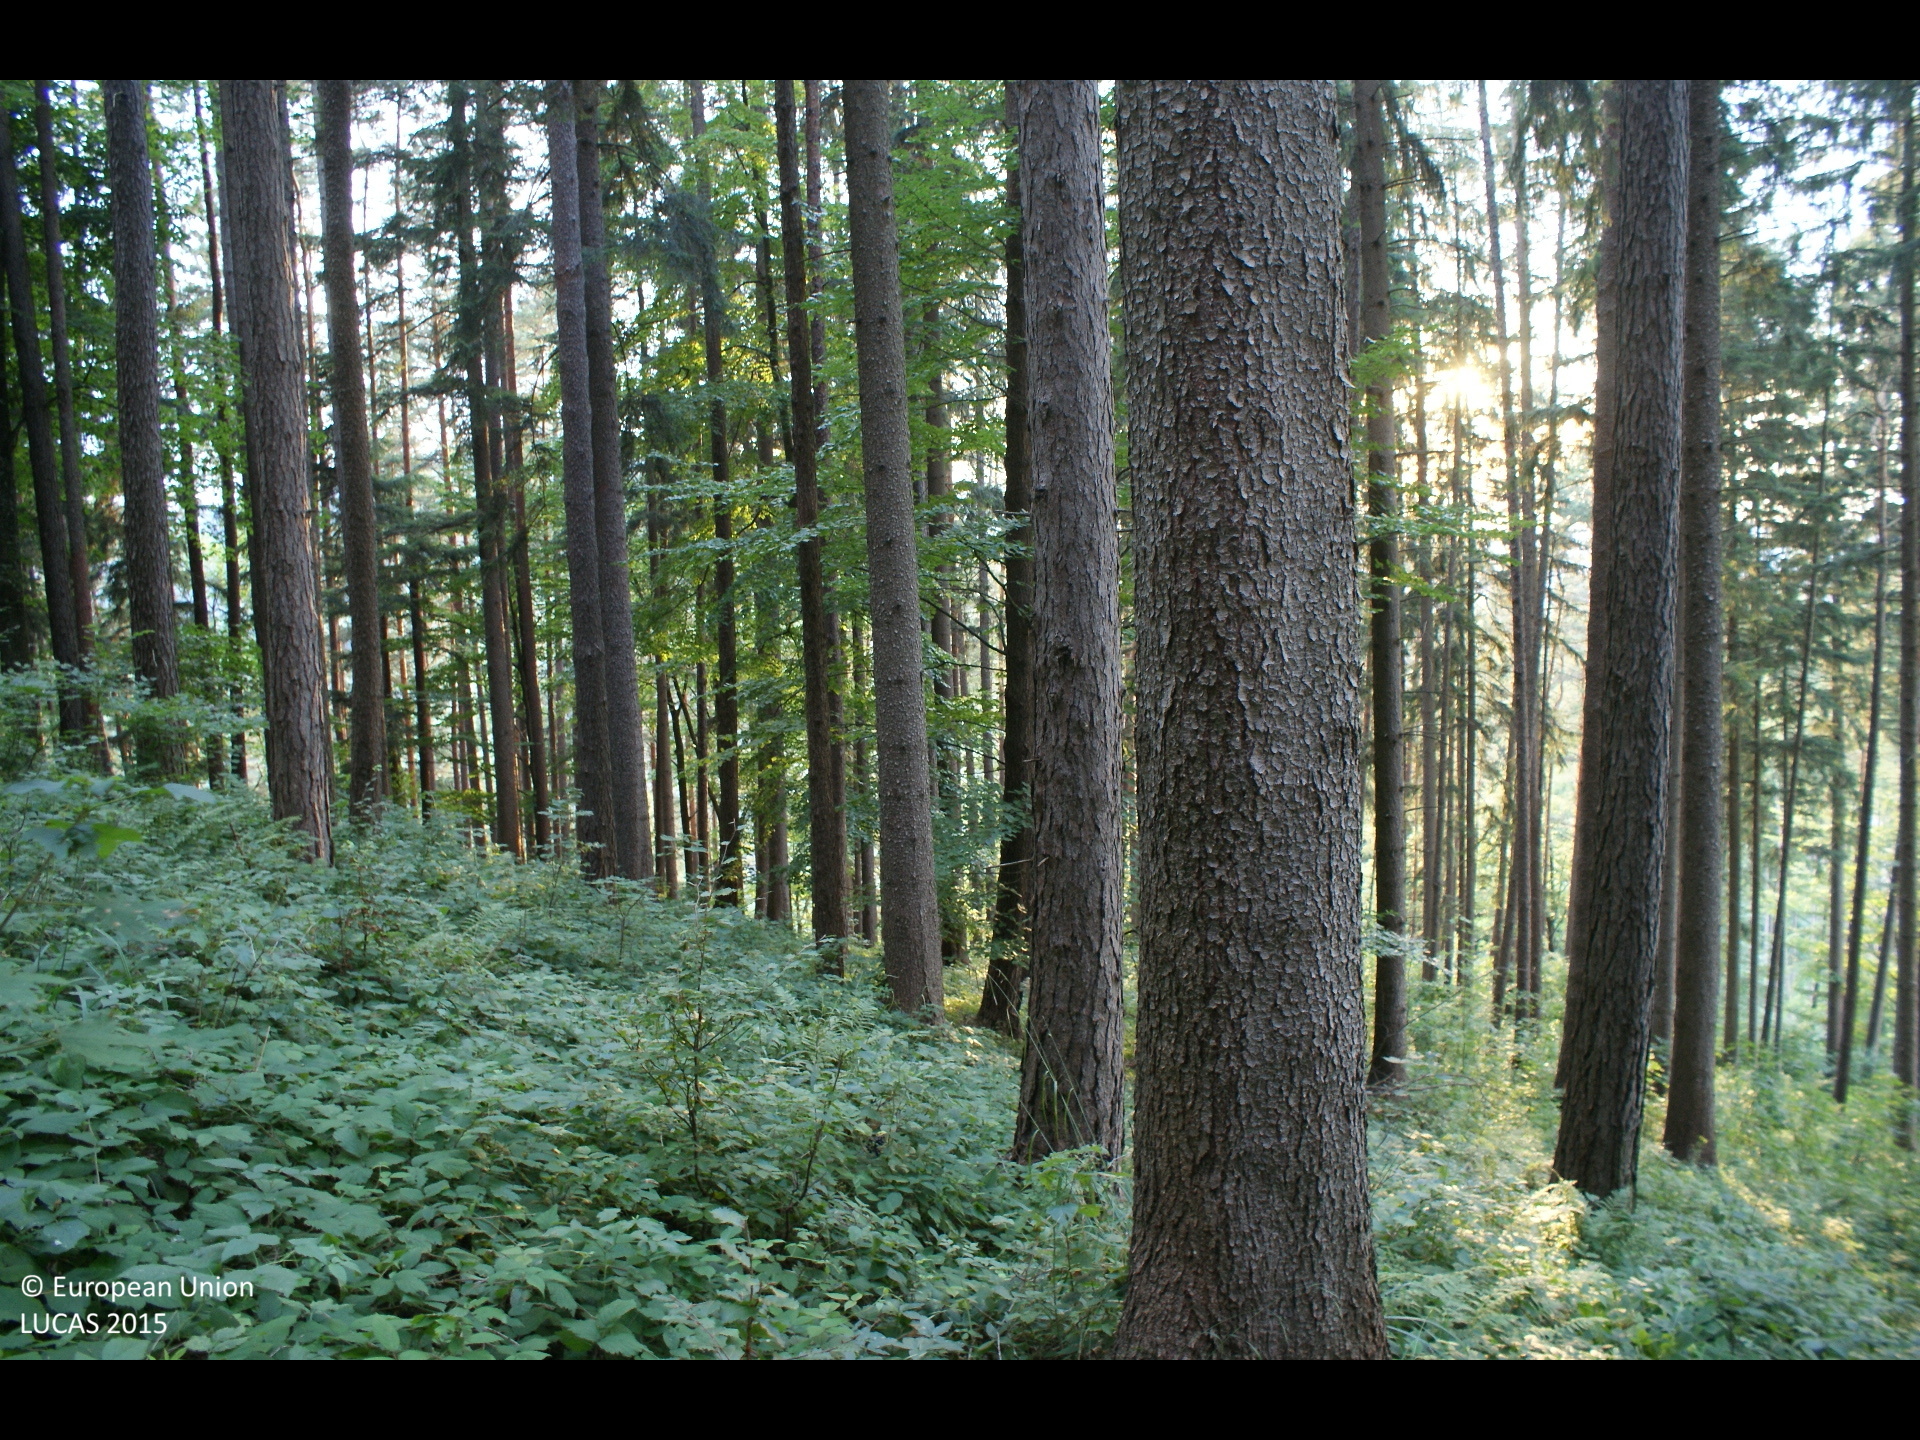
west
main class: Woodland
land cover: Other coniferous woodland
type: hemiboreal forest and nemoral coniferous forest and mixed broadleaved-coniferous forest
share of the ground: > 75 %
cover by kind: coniferous forest trees 80 %, herbaceous plants 15 %, shrubs 5 %
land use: Forestry
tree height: > 5 m
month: July
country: AT
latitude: 47.9373
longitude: 14.8329
